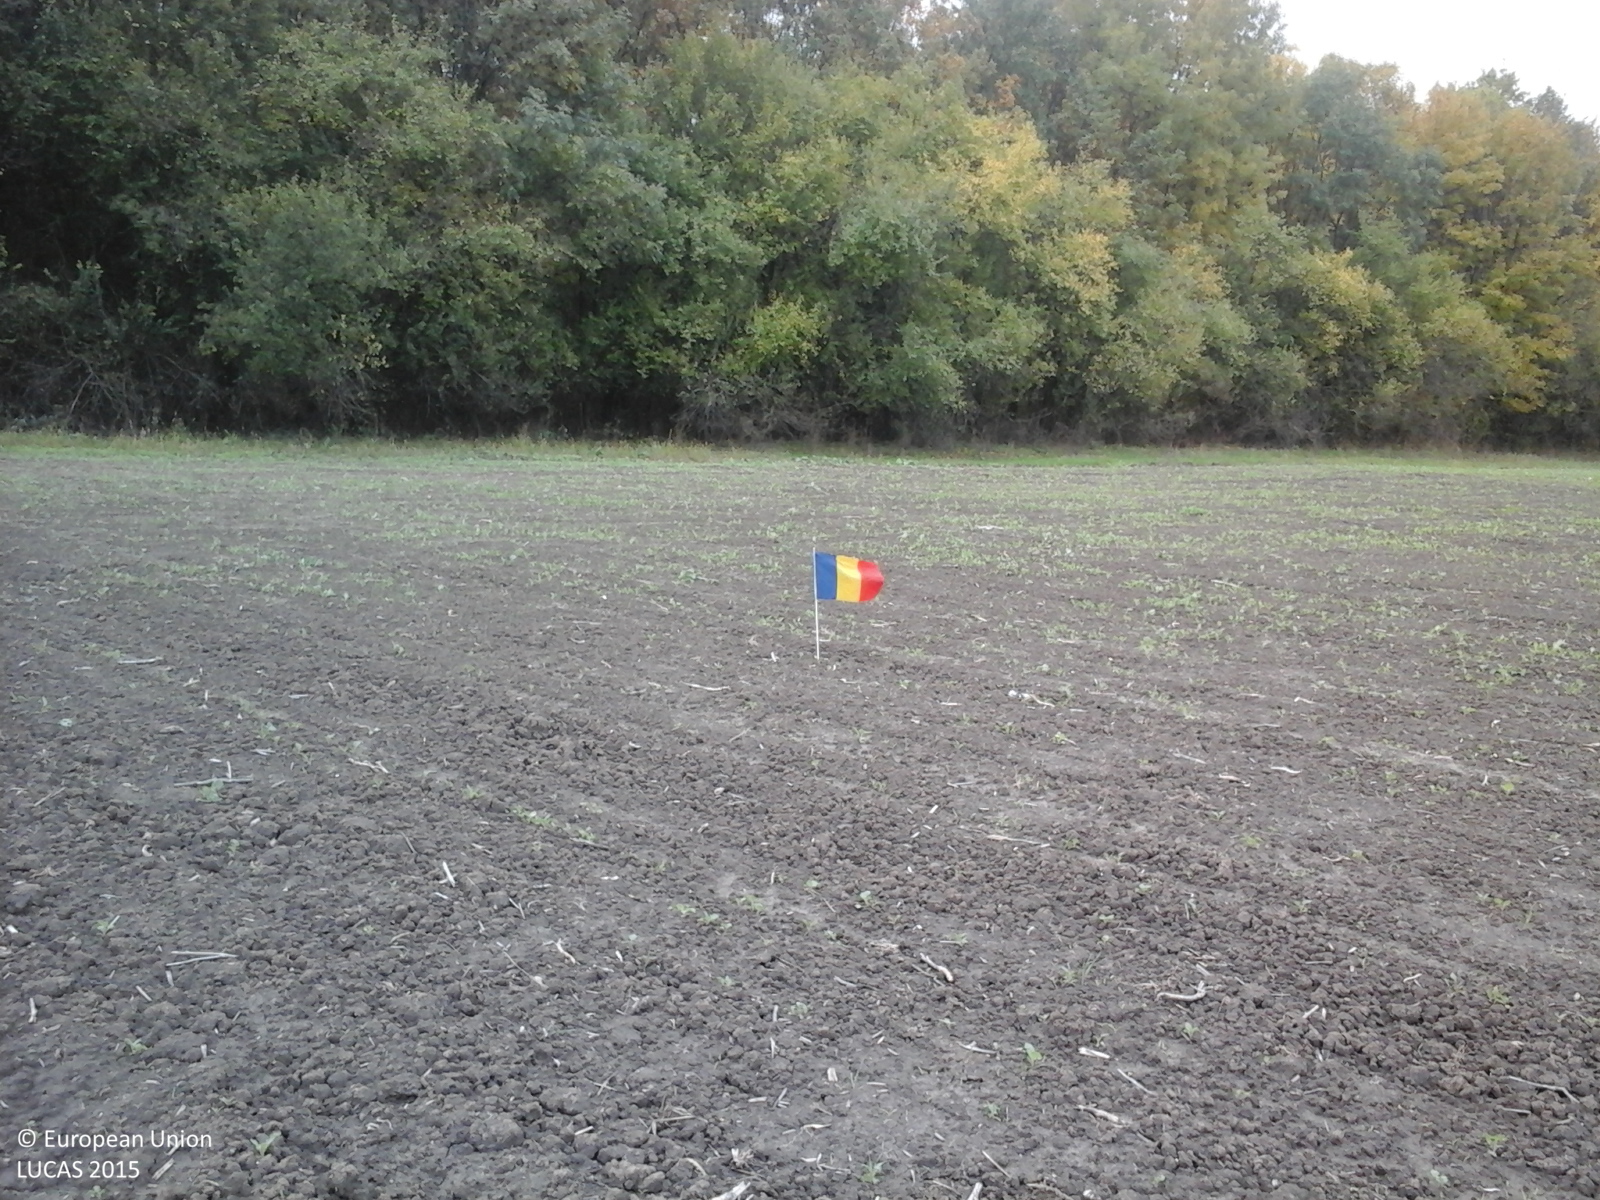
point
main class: Cropland
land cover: Rape and turnip rape
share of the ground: < 10 %
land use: Agriculture (excluding fallow land and kitchen gardens)
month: October
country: RO
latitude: 44.8459
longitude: 26.2181
